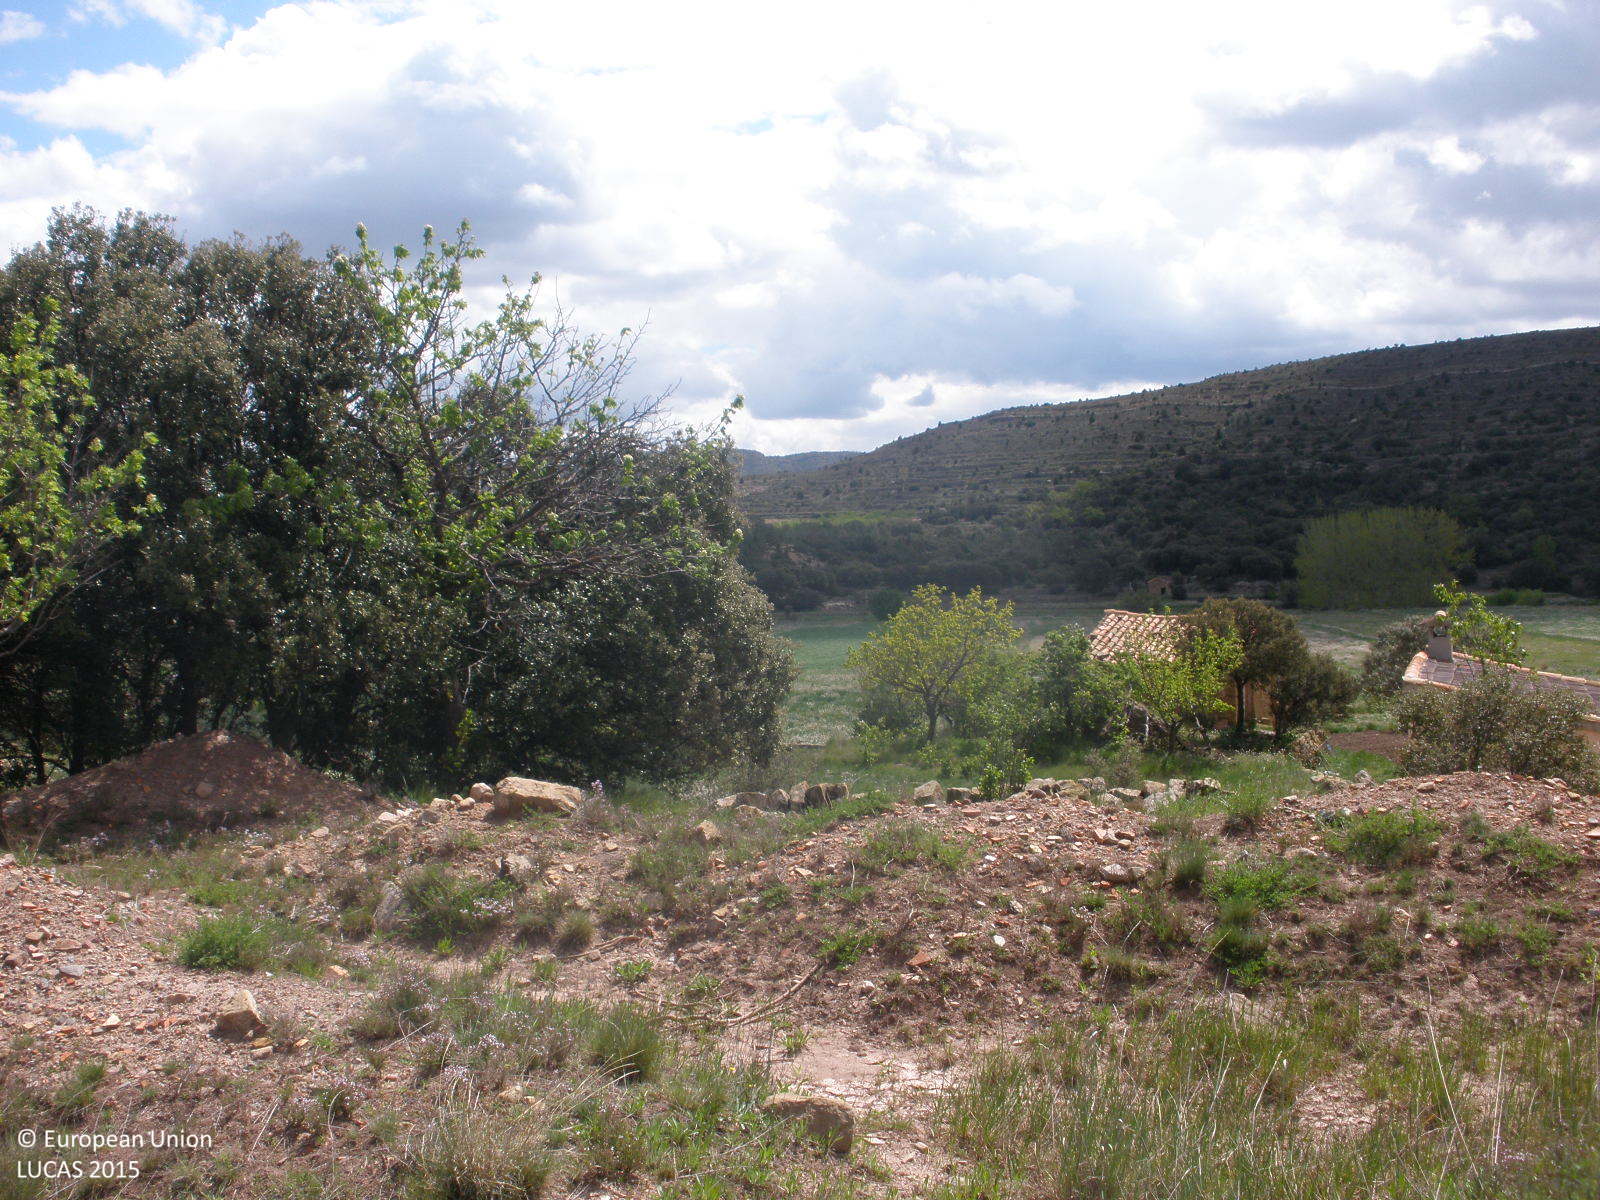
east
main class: Woodland
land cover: Broadleaved woodland
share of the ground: 10 - 25 %
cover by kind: herbaceous plants 70 %, broadleaved forest trees 20 %, consolidated bare surface 10 %
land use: Semi-natural and natural areas not in use
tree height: < 5 m
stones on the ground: < 10 %
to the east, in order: Broadleaved woodland; Dry stone walls; Ditches and canals; Grassland without tree/shrub cover; Dry stone walls; Tracks; Dry stone walls; Grassland without tree/shrub cover; Dry stone walls; Grassland without tree/shrub cover; Dry stone walls; Grassland without tree/shrub cover; Groves; Spontaneously vegetated surfaces; Artificial constructions; Spontaneously vegetated surfaces; Artificial constructions; Tracks; Spontaneously vegetated surfaces
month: April
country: ES
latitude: 40.2388
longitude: -0.7625
